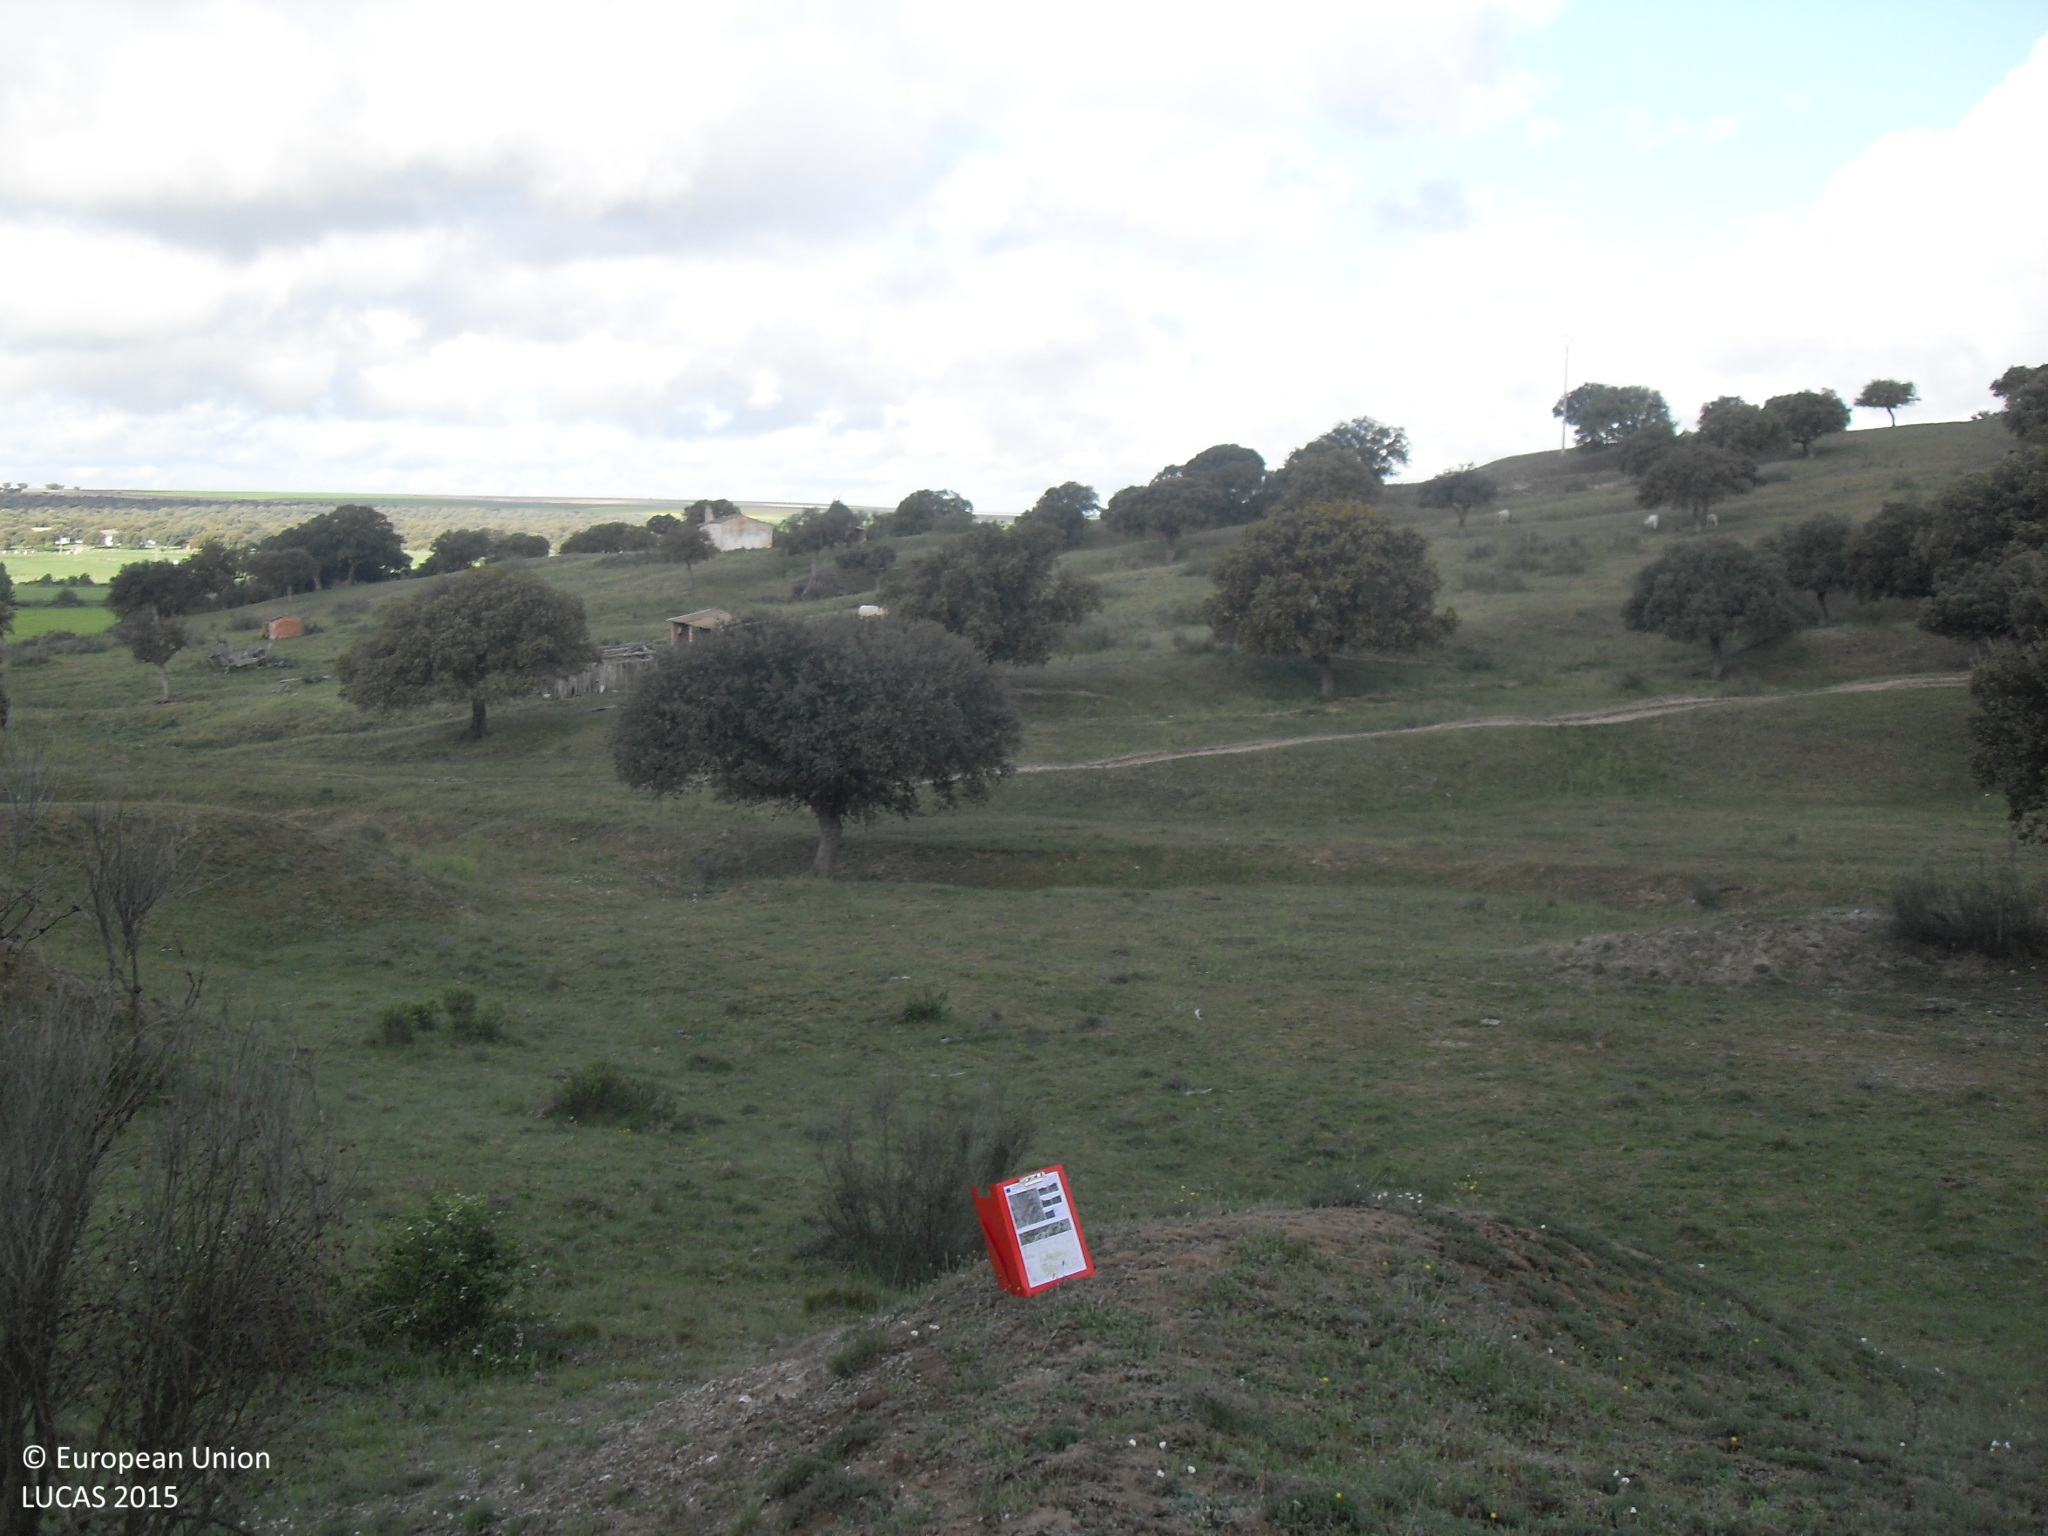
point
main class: Woodland
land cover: Broadleaved woodland
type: broadleaved evergreen forest
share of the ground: 10 - 25 %
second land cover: Grassland without tree/shrub cover
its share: > 75 %
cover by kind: herbaceous plants 85 %, broadleaved forest trees 15 %
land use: Forestry
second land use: Agriculture (excluding fallow land and kitchen gardens)
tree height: > 5 m
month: May
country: ES
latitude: 40.8475
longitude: -5.1413
